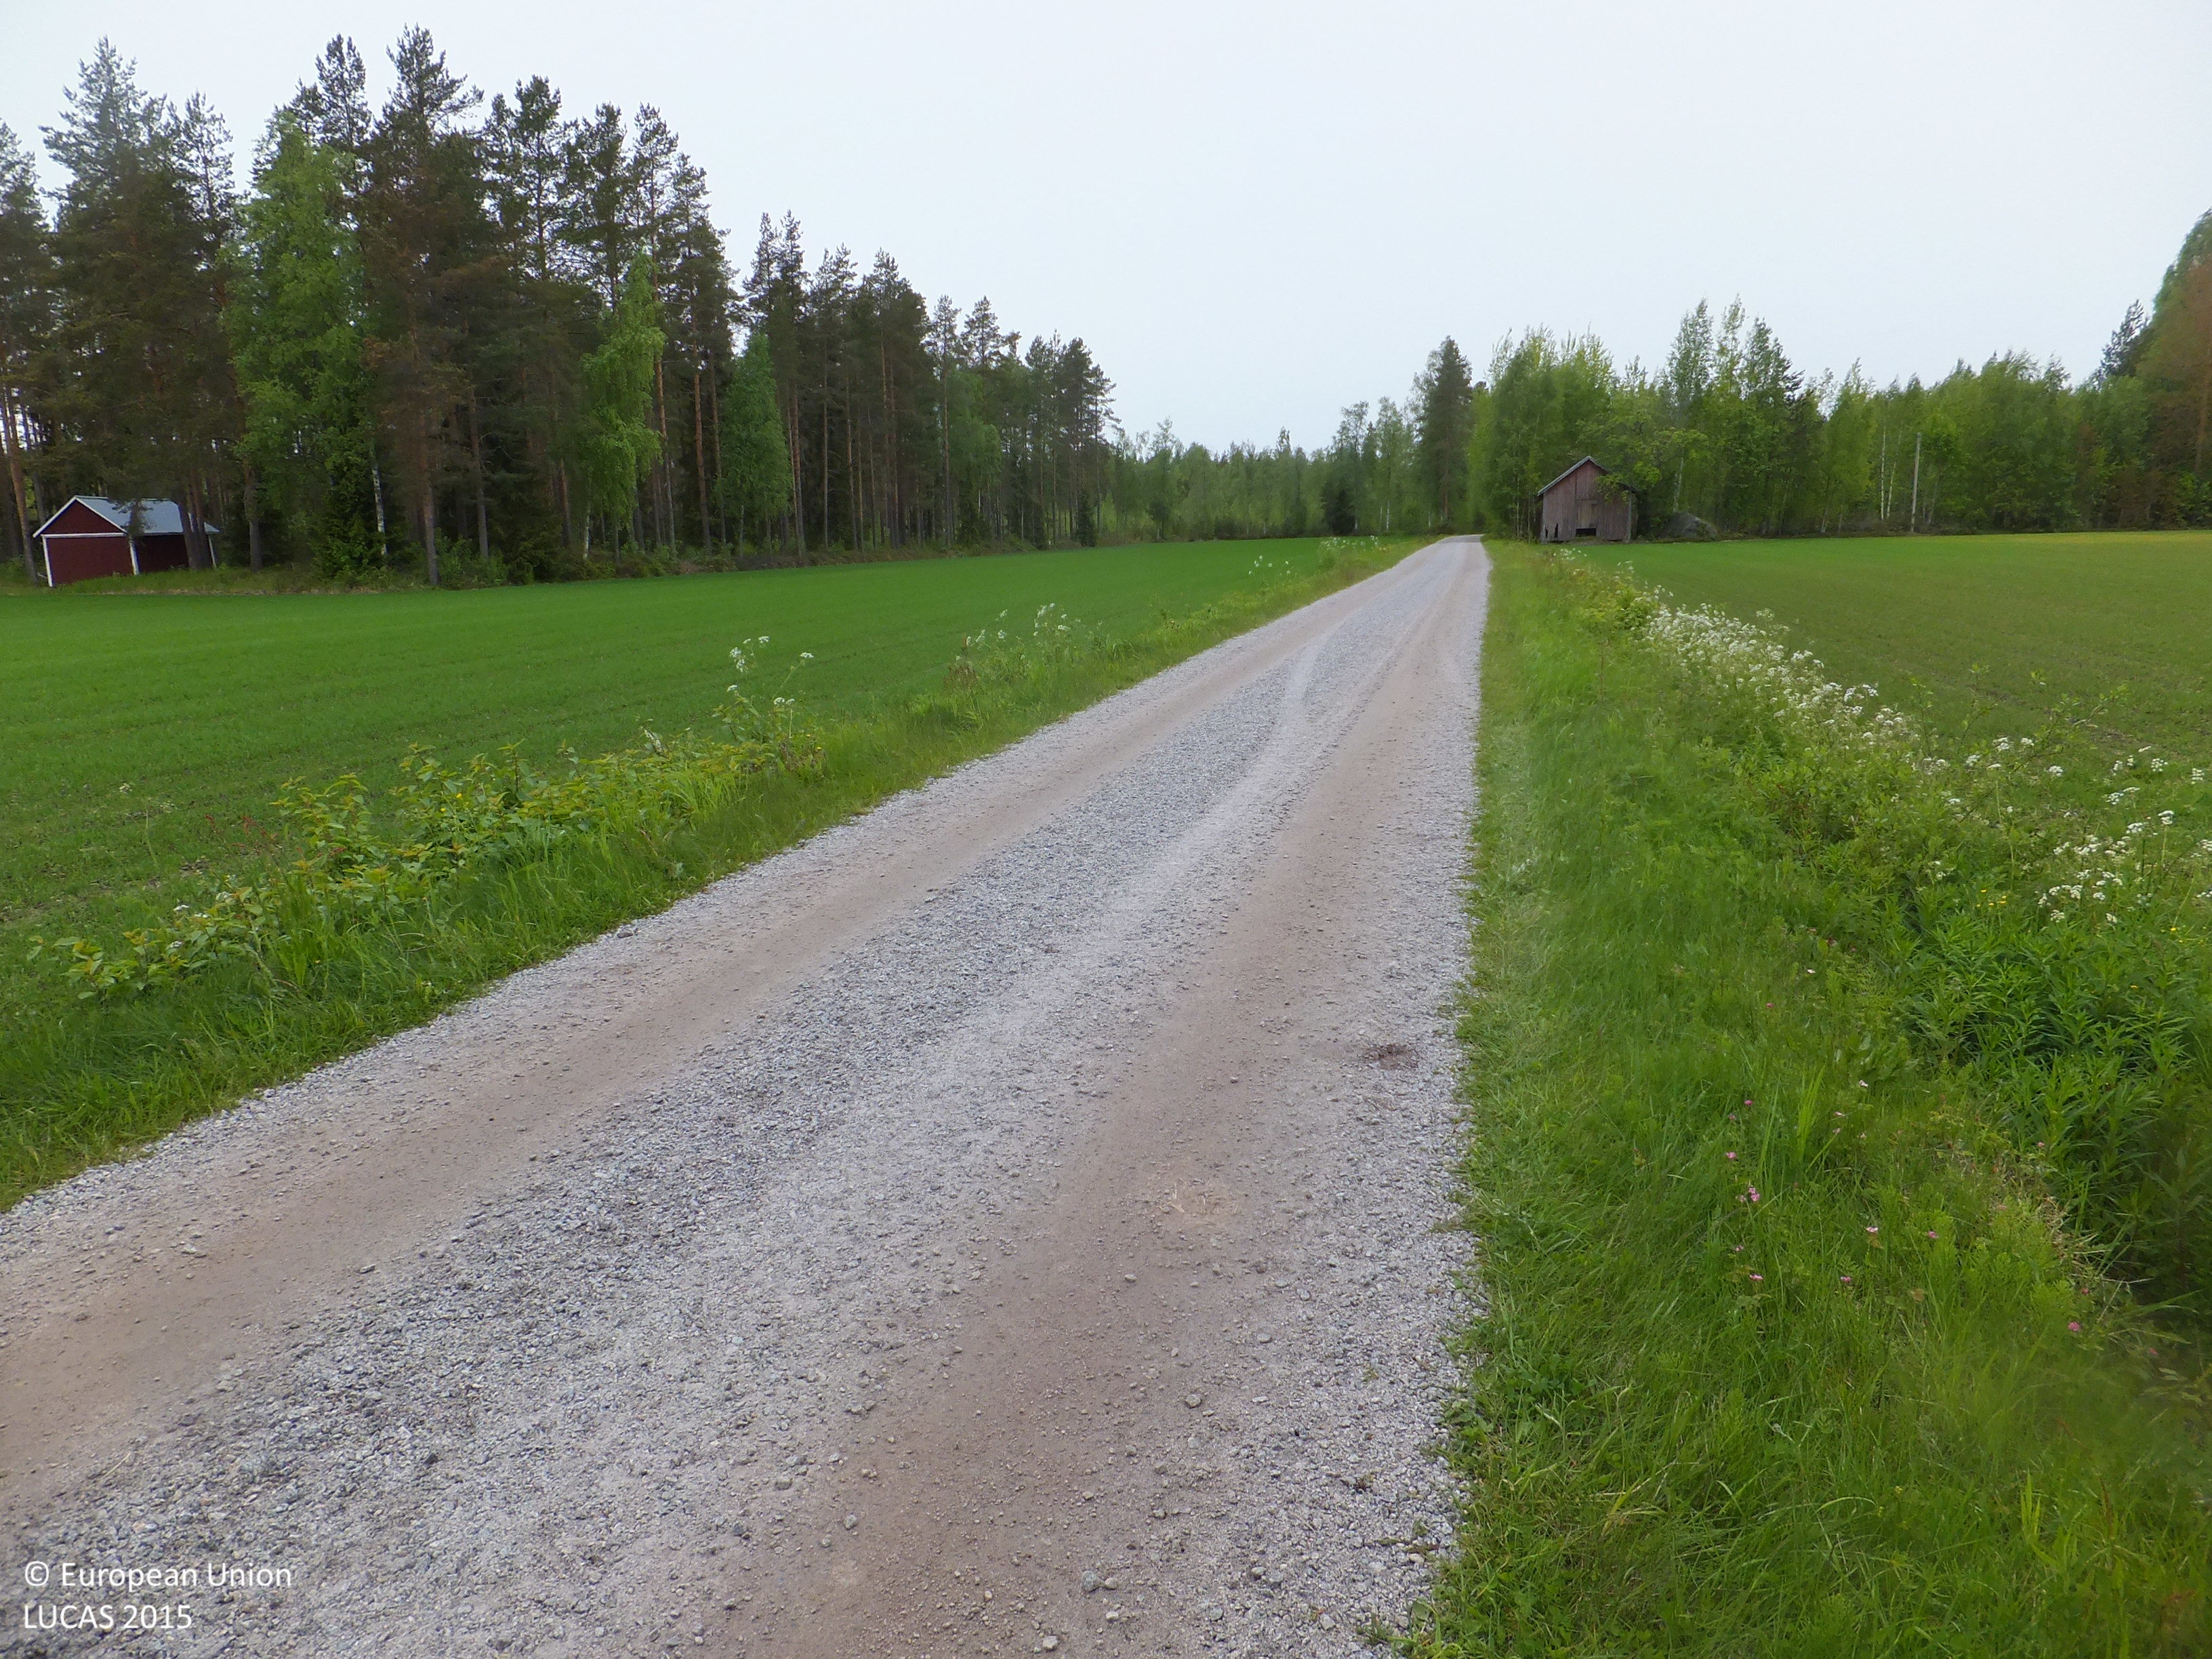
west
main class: Grassland
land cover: Grassland without tree/shrub cover
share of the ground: > 75 %
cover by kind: herbaceous plants 100 %
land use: Residential
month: June
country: FI
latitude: 63.2509
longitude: 22.6172
